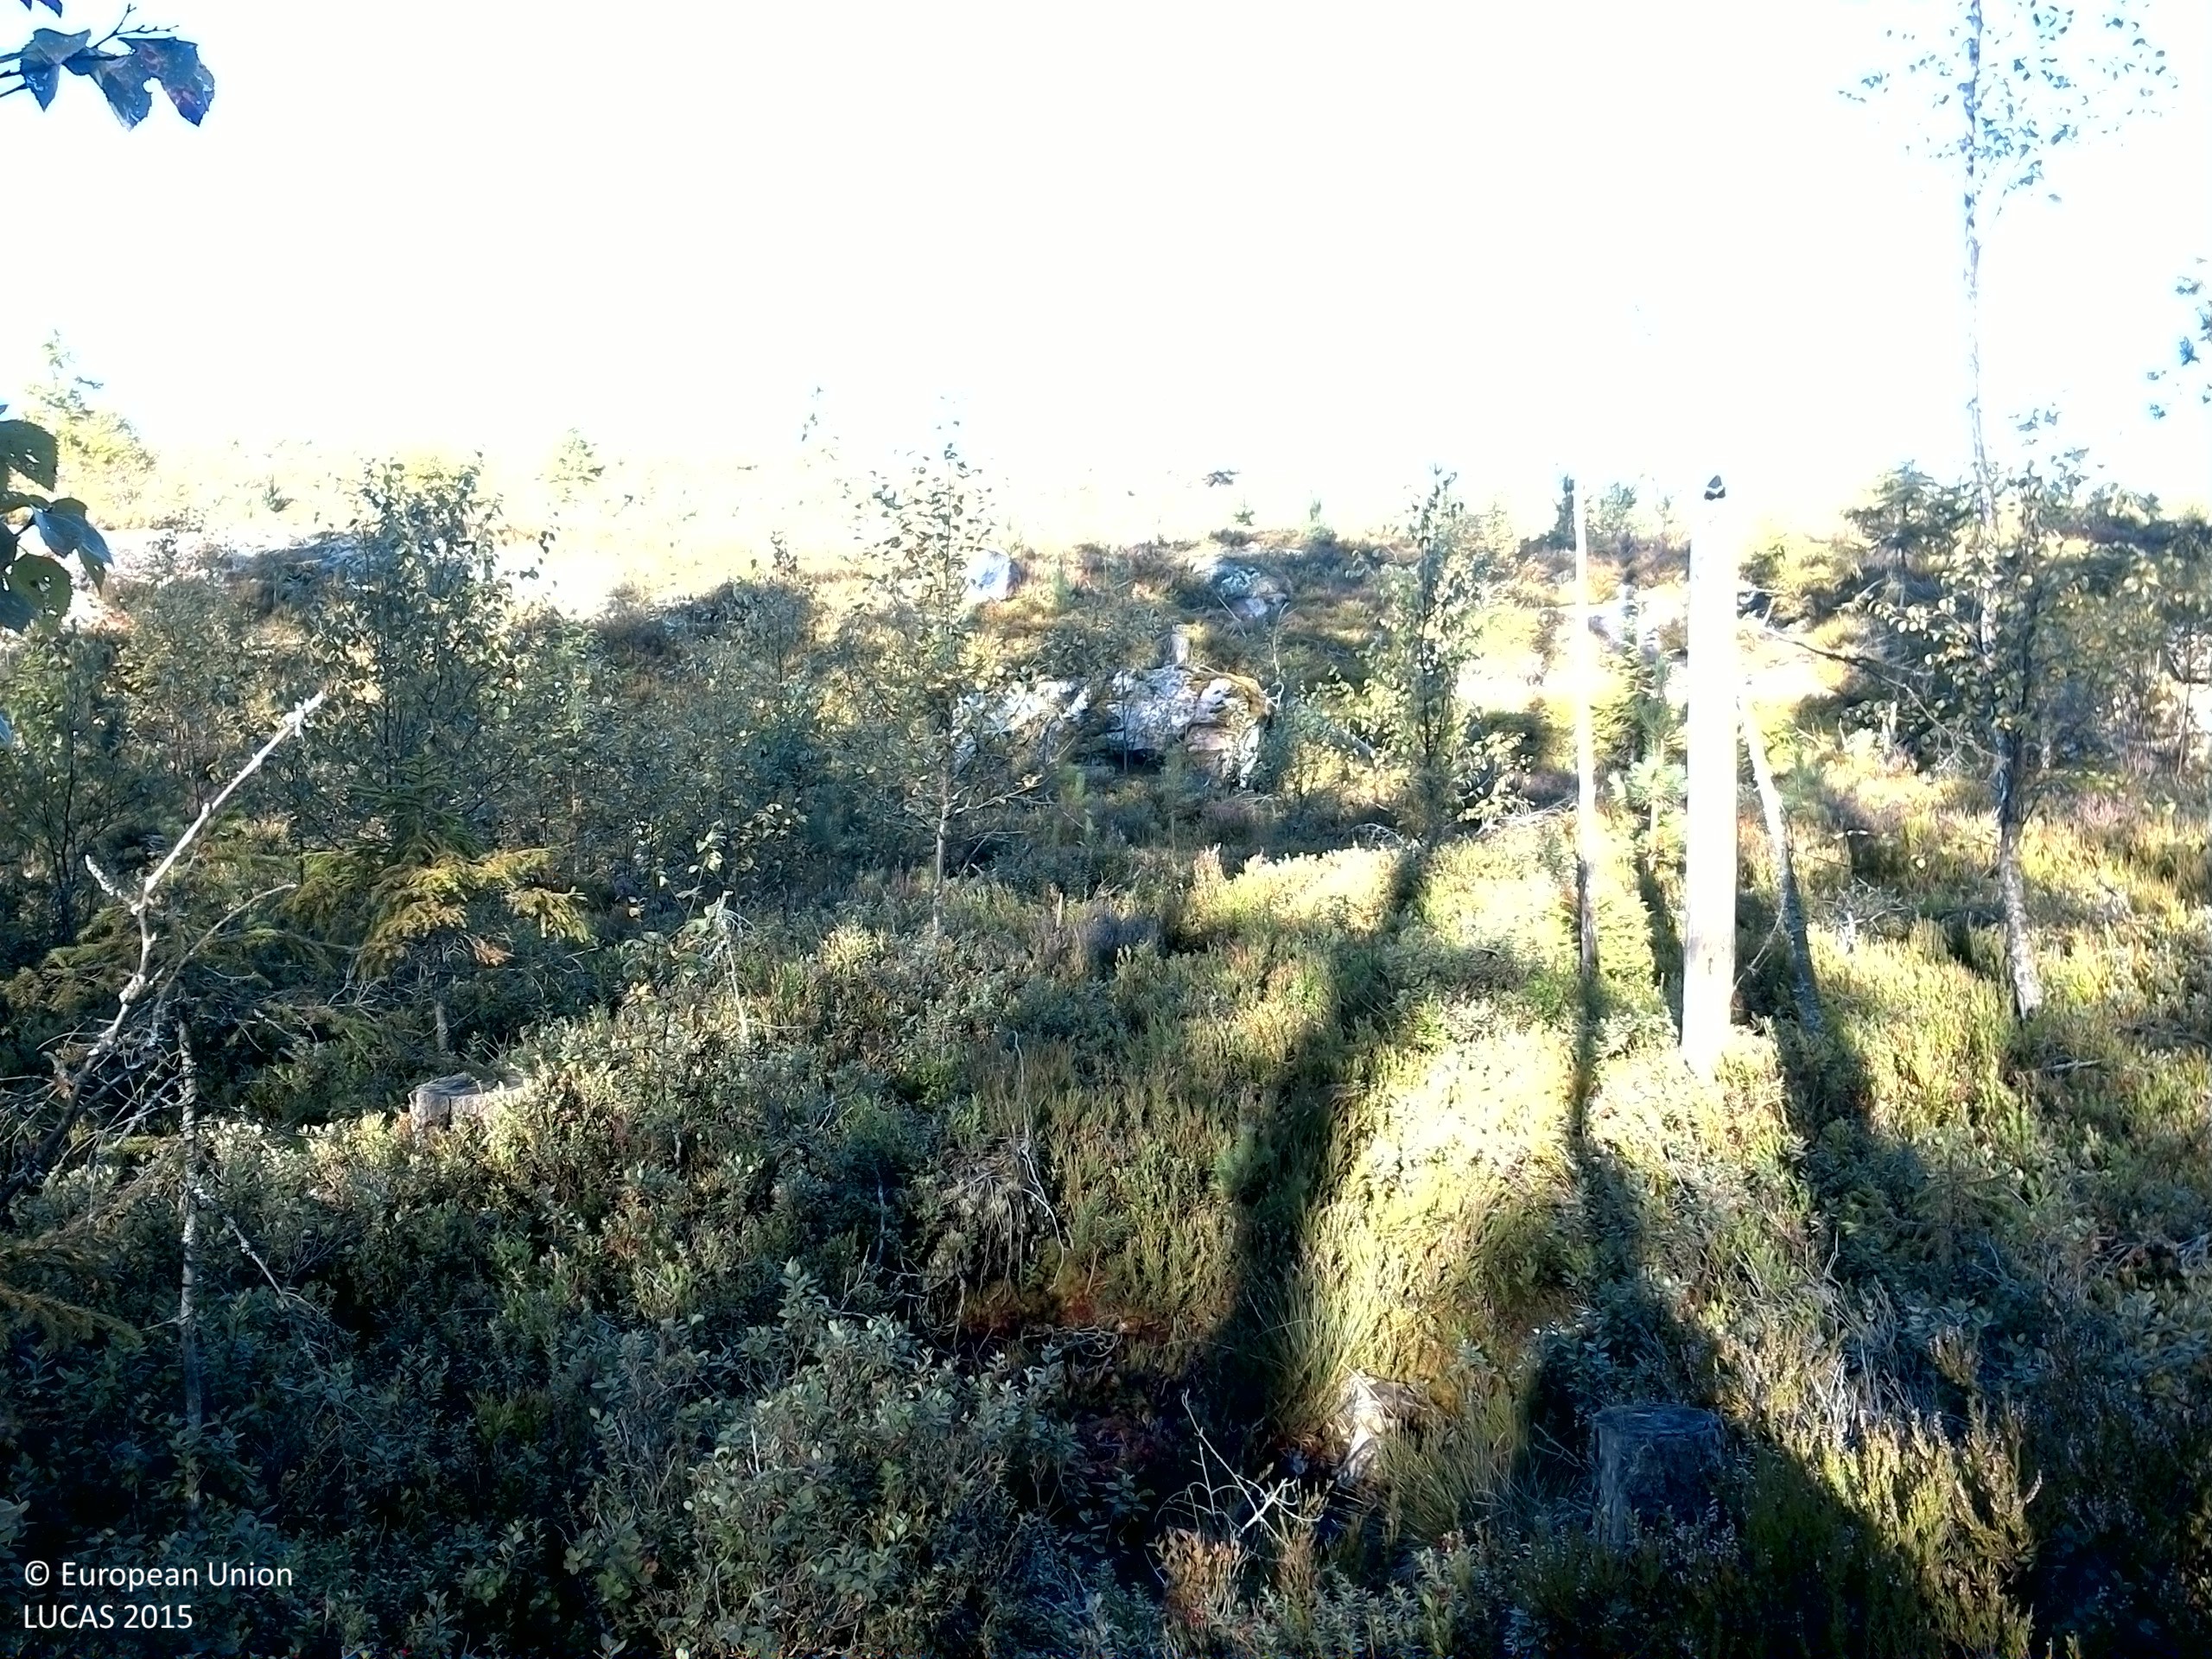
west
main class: Woodland
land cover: Pine dominated coniferous woodland
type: boreal forest
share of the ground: 50 - 75 %
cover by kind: coniferous forest trees 65 %, shrubs 25 %, broadleaved forest trees 5 %, lichens and mosses 5 %
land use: Forestry
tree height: > 5 m
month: September
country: SE
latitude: 59.8334
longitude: 13.3989
